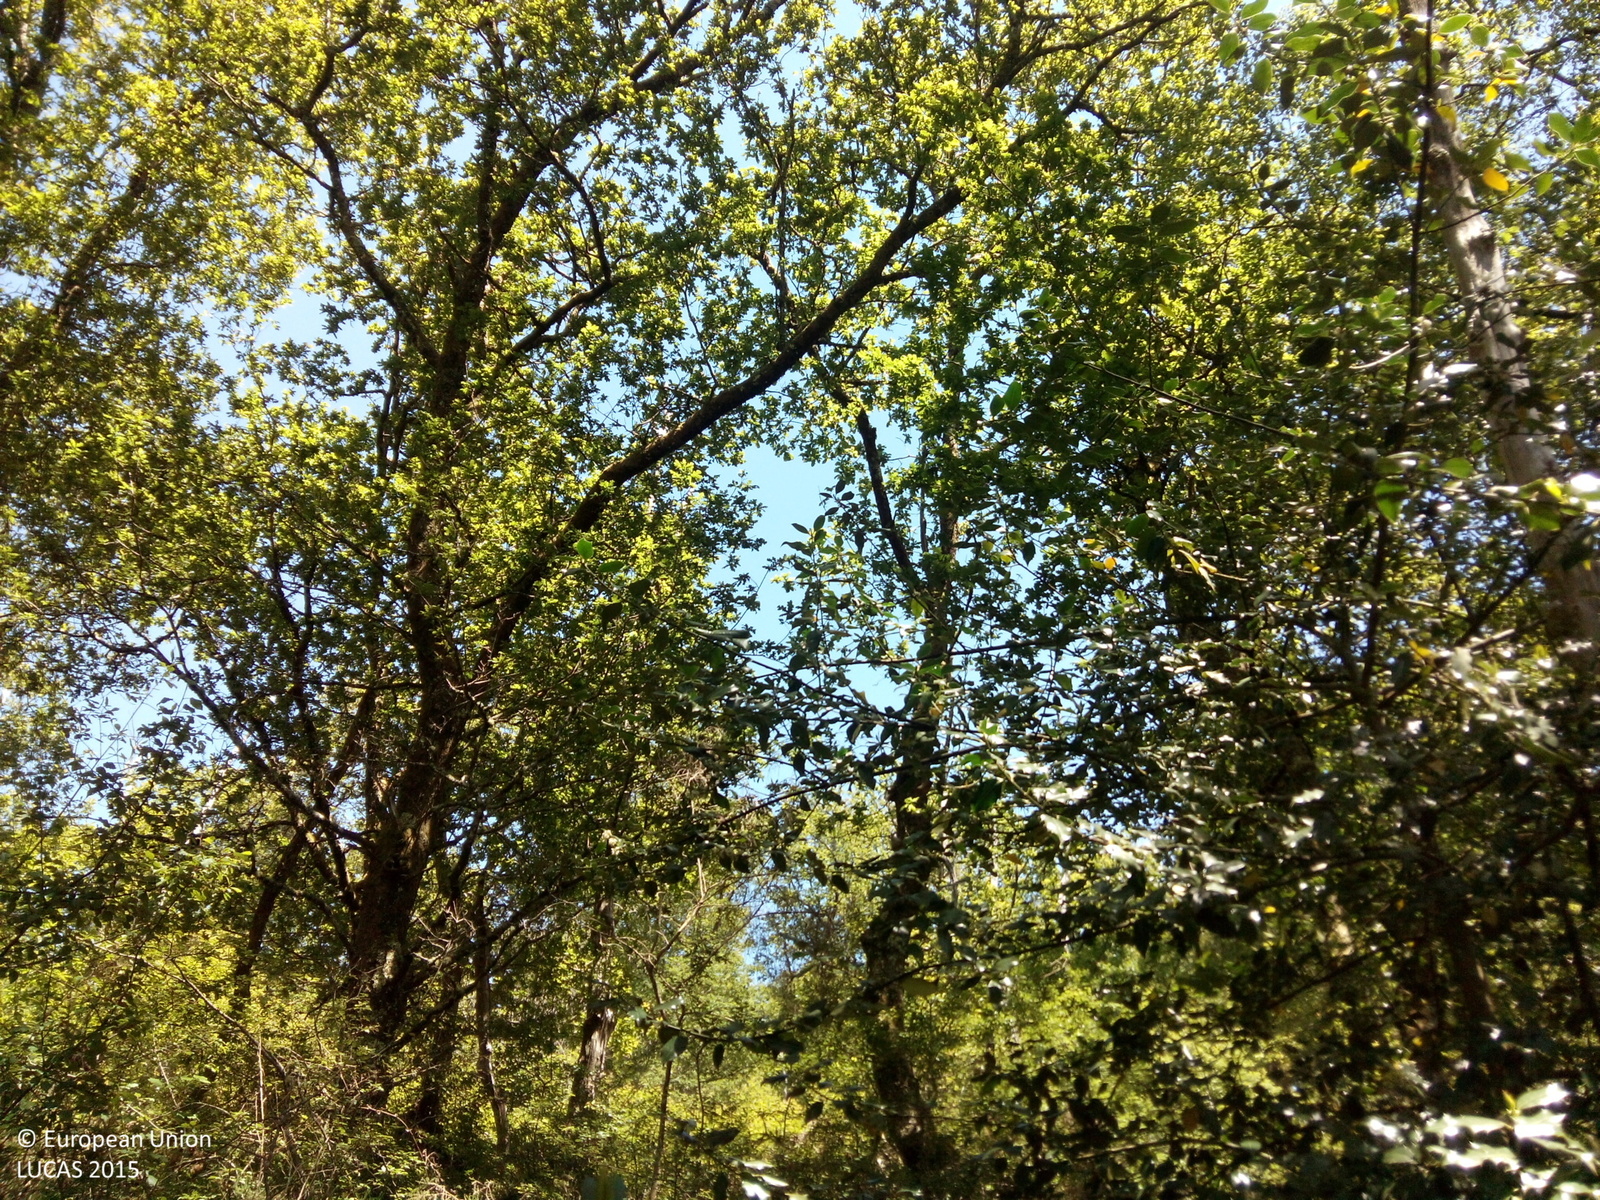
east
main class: Woodland
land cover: Broadleaved woodland
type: acidophilous oak and oak-birch forest
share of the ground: > 75 %
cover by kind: broadleaved forest trees 100 %
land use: Forestry
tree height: > 5 m
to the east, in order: Broadleaved woodland; Tracks; Broadleaved woodland
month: May
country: ES
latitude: 42.6015
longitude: -8.3657
